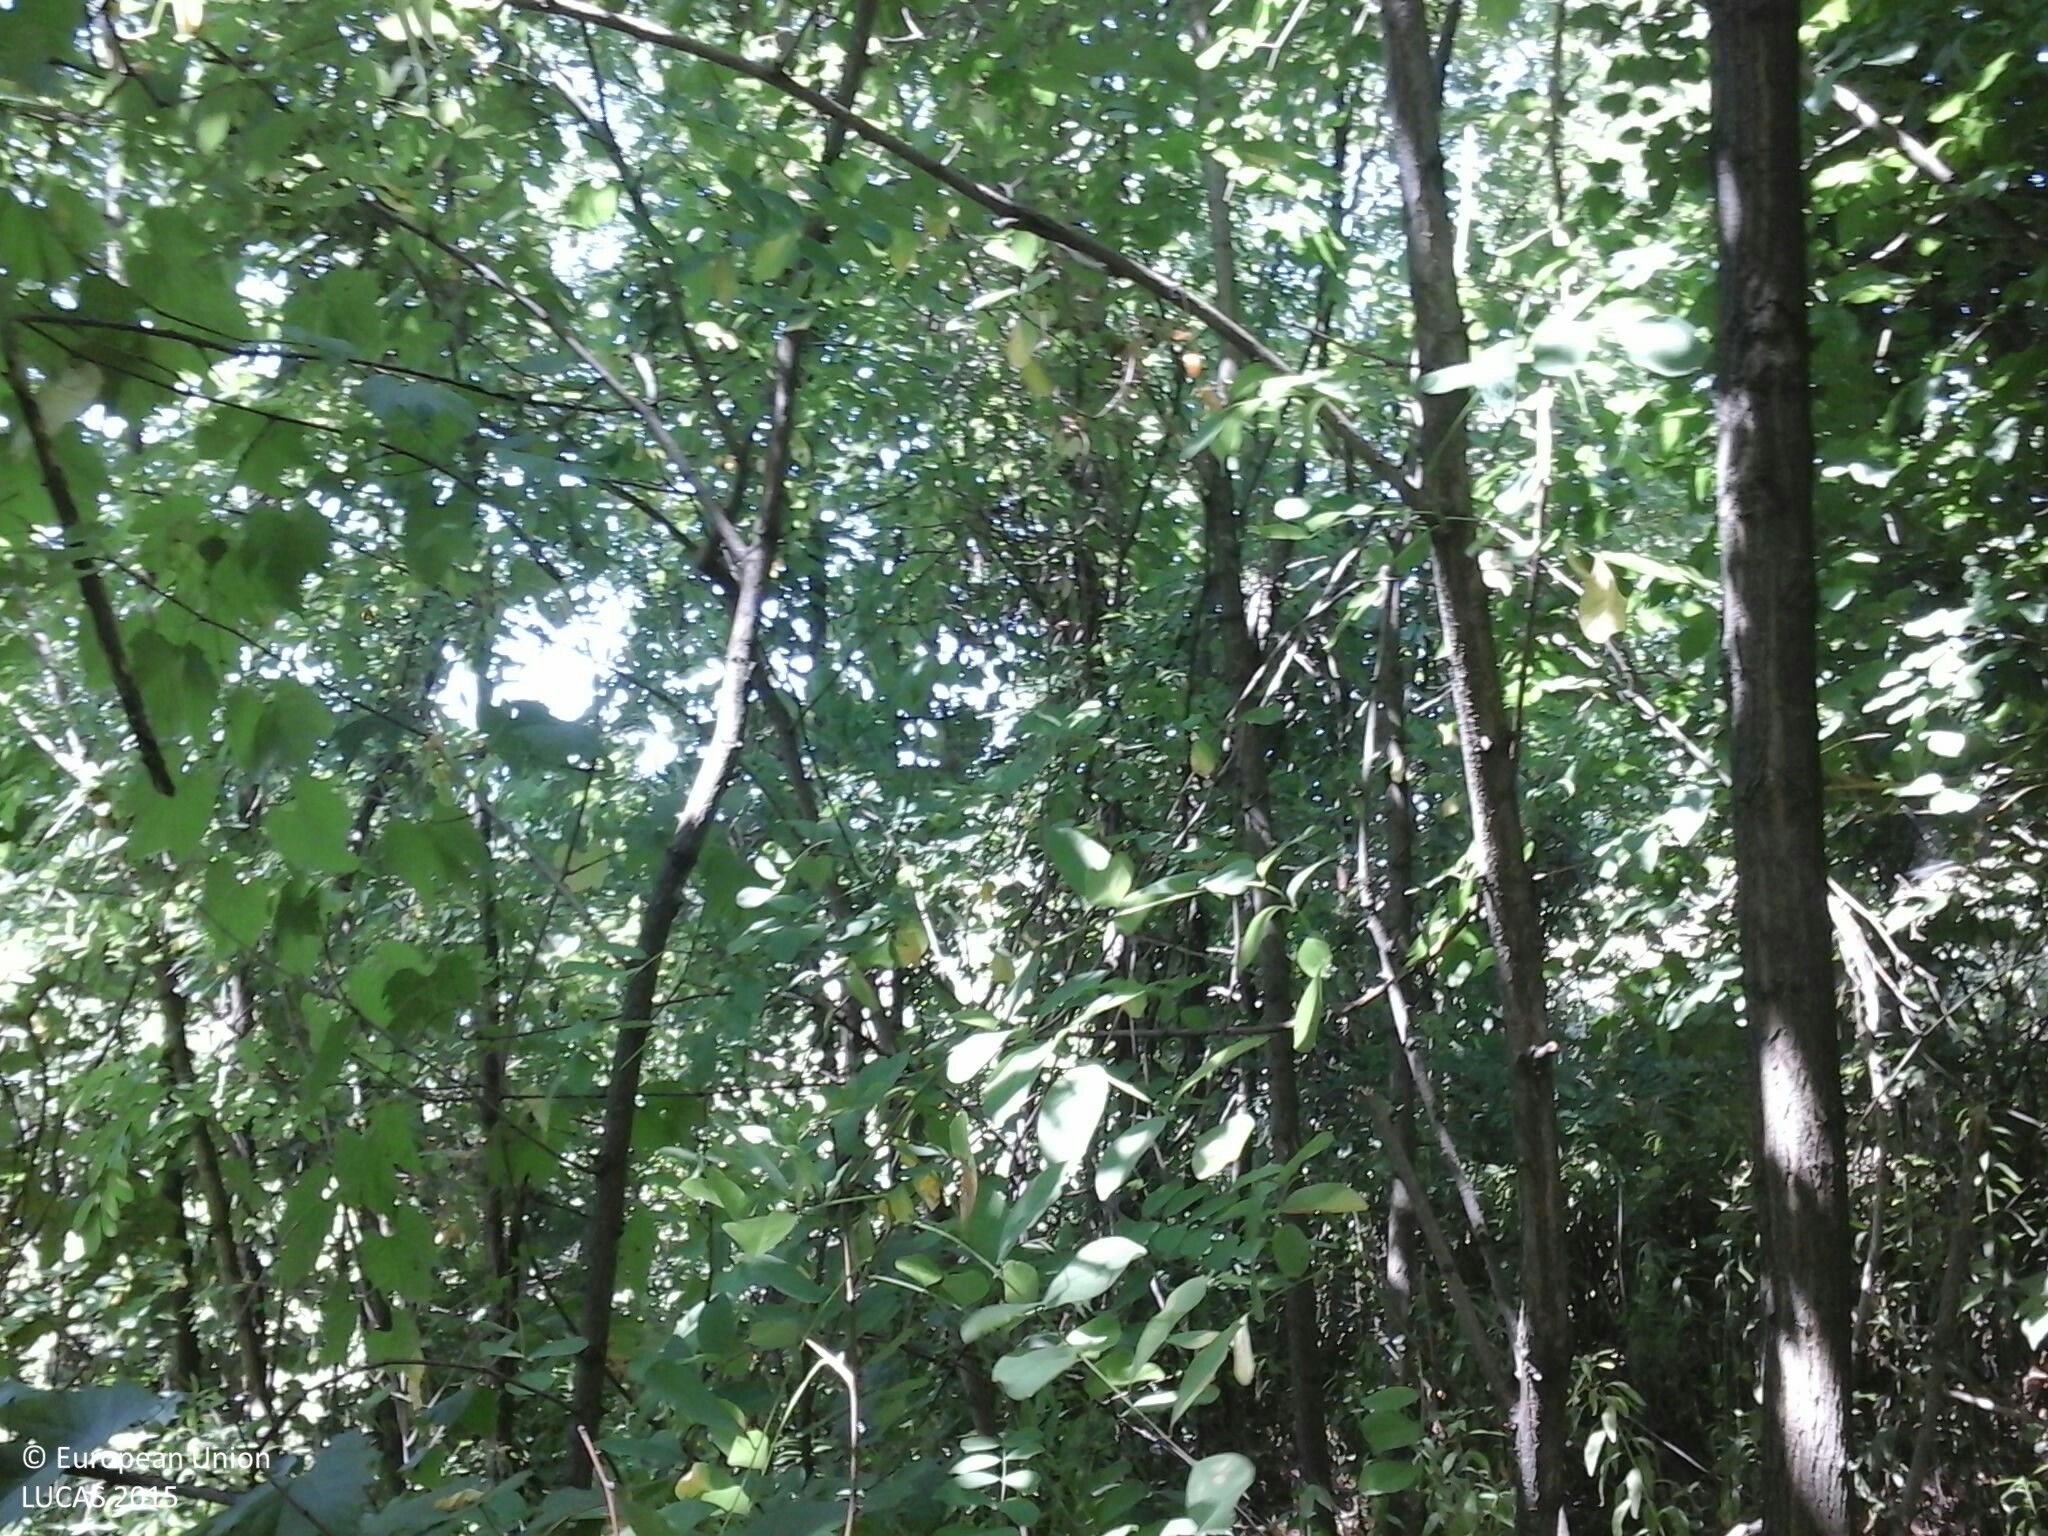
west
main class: Woodland
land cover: Broadleaved woodland
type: mesophytic deciduous forest
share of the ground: > 75 %
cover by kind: broadleaved forest trees 95 %, herbaceous plants 5 %
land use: Semi-natural and natural areas not in use
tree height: < 5 m
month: July
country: HU
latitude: 46.8512
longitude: 17.4419
